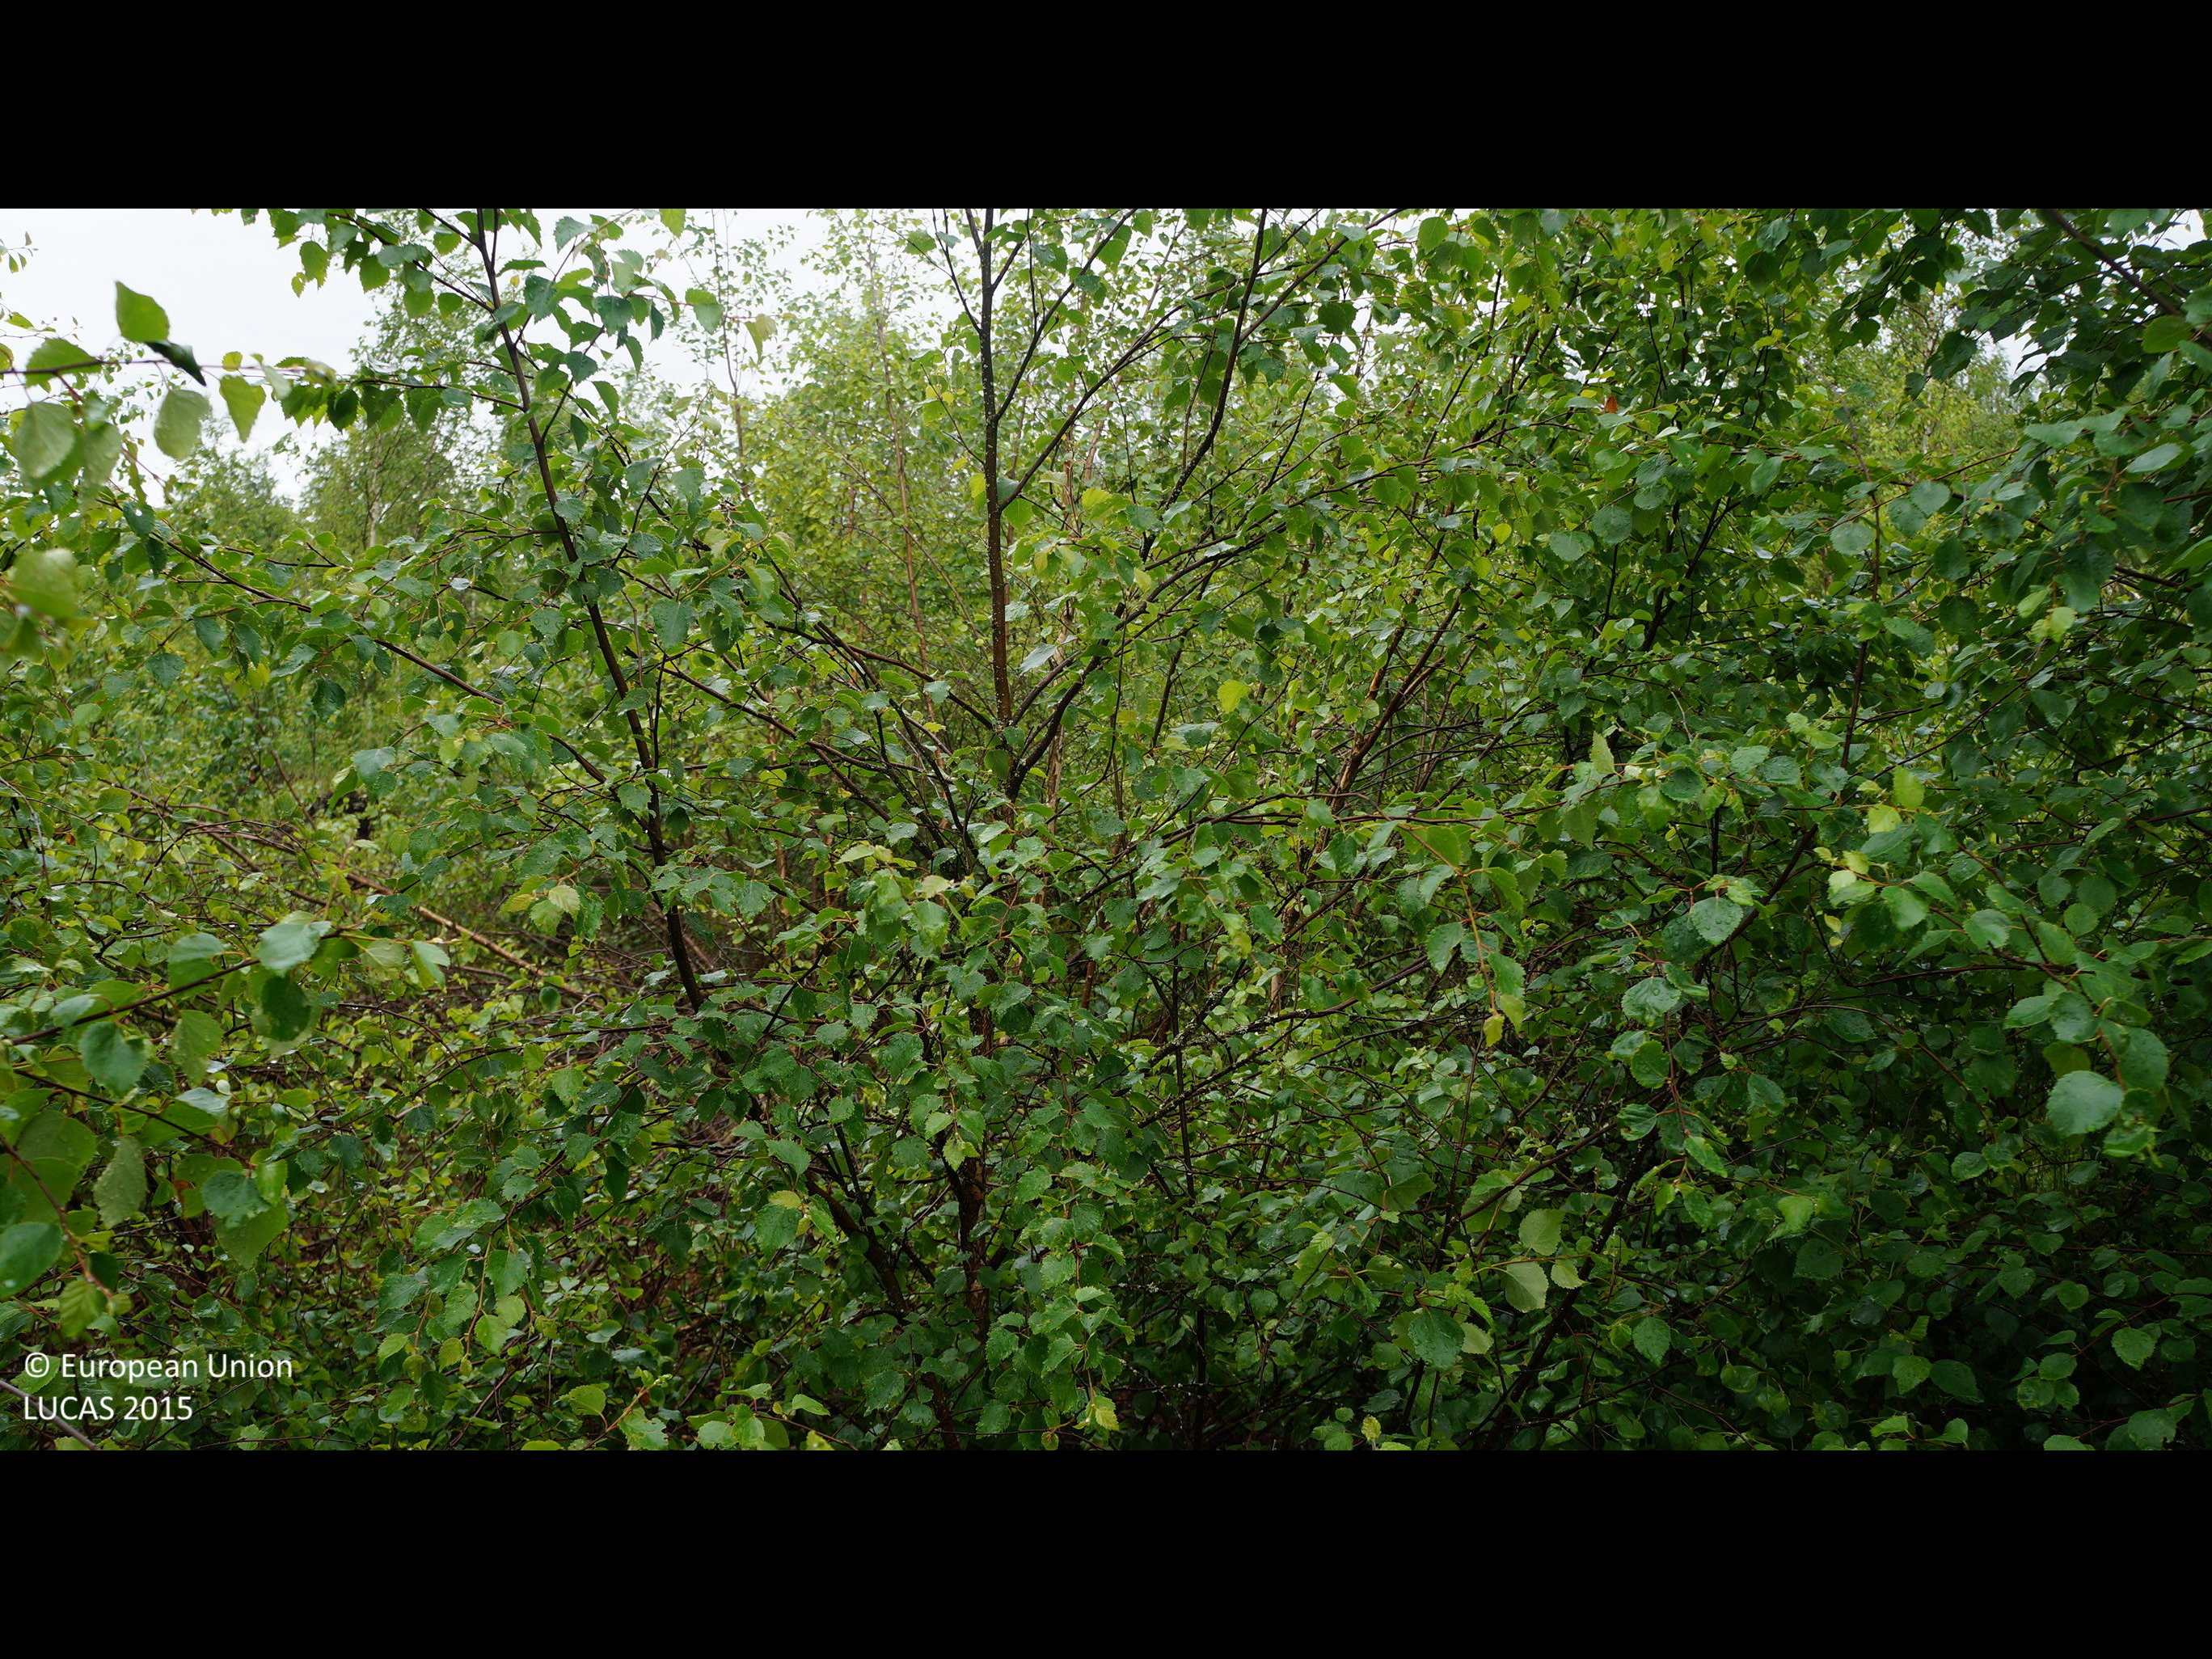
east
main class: Woodland
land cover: Broadleaved woodland
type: boreal forest
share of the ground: > 75 %
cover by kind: broadleaved forest trees 70 %, shrubs 15 %, coniferous forest trees 10 %, lichens and mosses 5 %
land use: Forestry
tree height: > 5 m
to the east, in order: Broadleaved woodland; Ditches and canals; Broadleaved woodland; Ditches and canals; Broadleaved woodland; Ditches and canals; Broadleaved woodland; Ditches and canals; Broadleaved woodland; Ditches and canals; Broadleaved woodland; Ditches and canals; Broadleaved woodland; Ditches and canals; Broadleaved woodland; Ditches and canals; Broadleaved woodland; Pine dominated mixed woodland; Ditches and canals; Broadleaved woodland; Ditches and canals; Abandoned hedges; Shruby margins; Tracks; Shruby margins; Abandoned hedges; Ditches and canals; Temporary grasslands
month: June
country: FI
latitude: 64.3110
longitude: 24.5663
